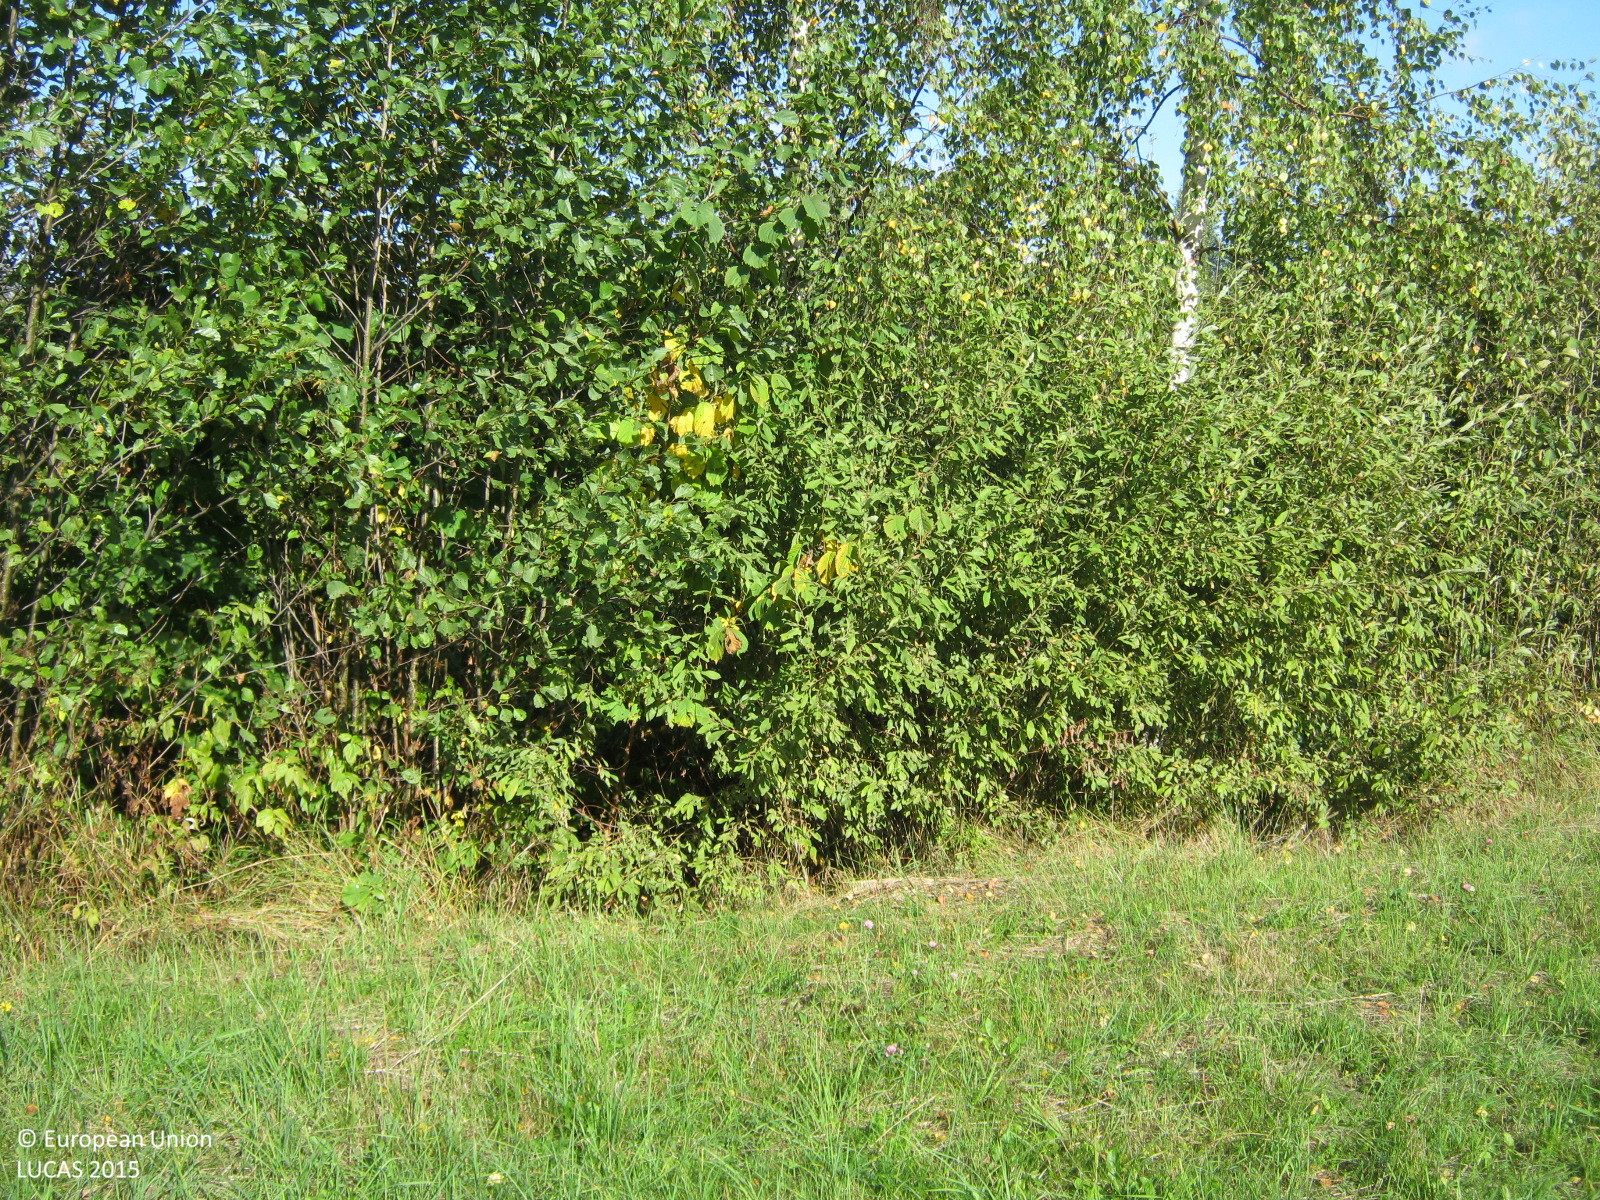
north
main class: Grassland
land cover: Grassland without tree/shrub cover
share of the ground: > 75 %
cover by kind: herbaceous plants 100 %
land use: Agriculture (excluding fallow land and kitchen gardens)
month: September
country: LV
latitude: 57.3644
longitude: 24.4043
